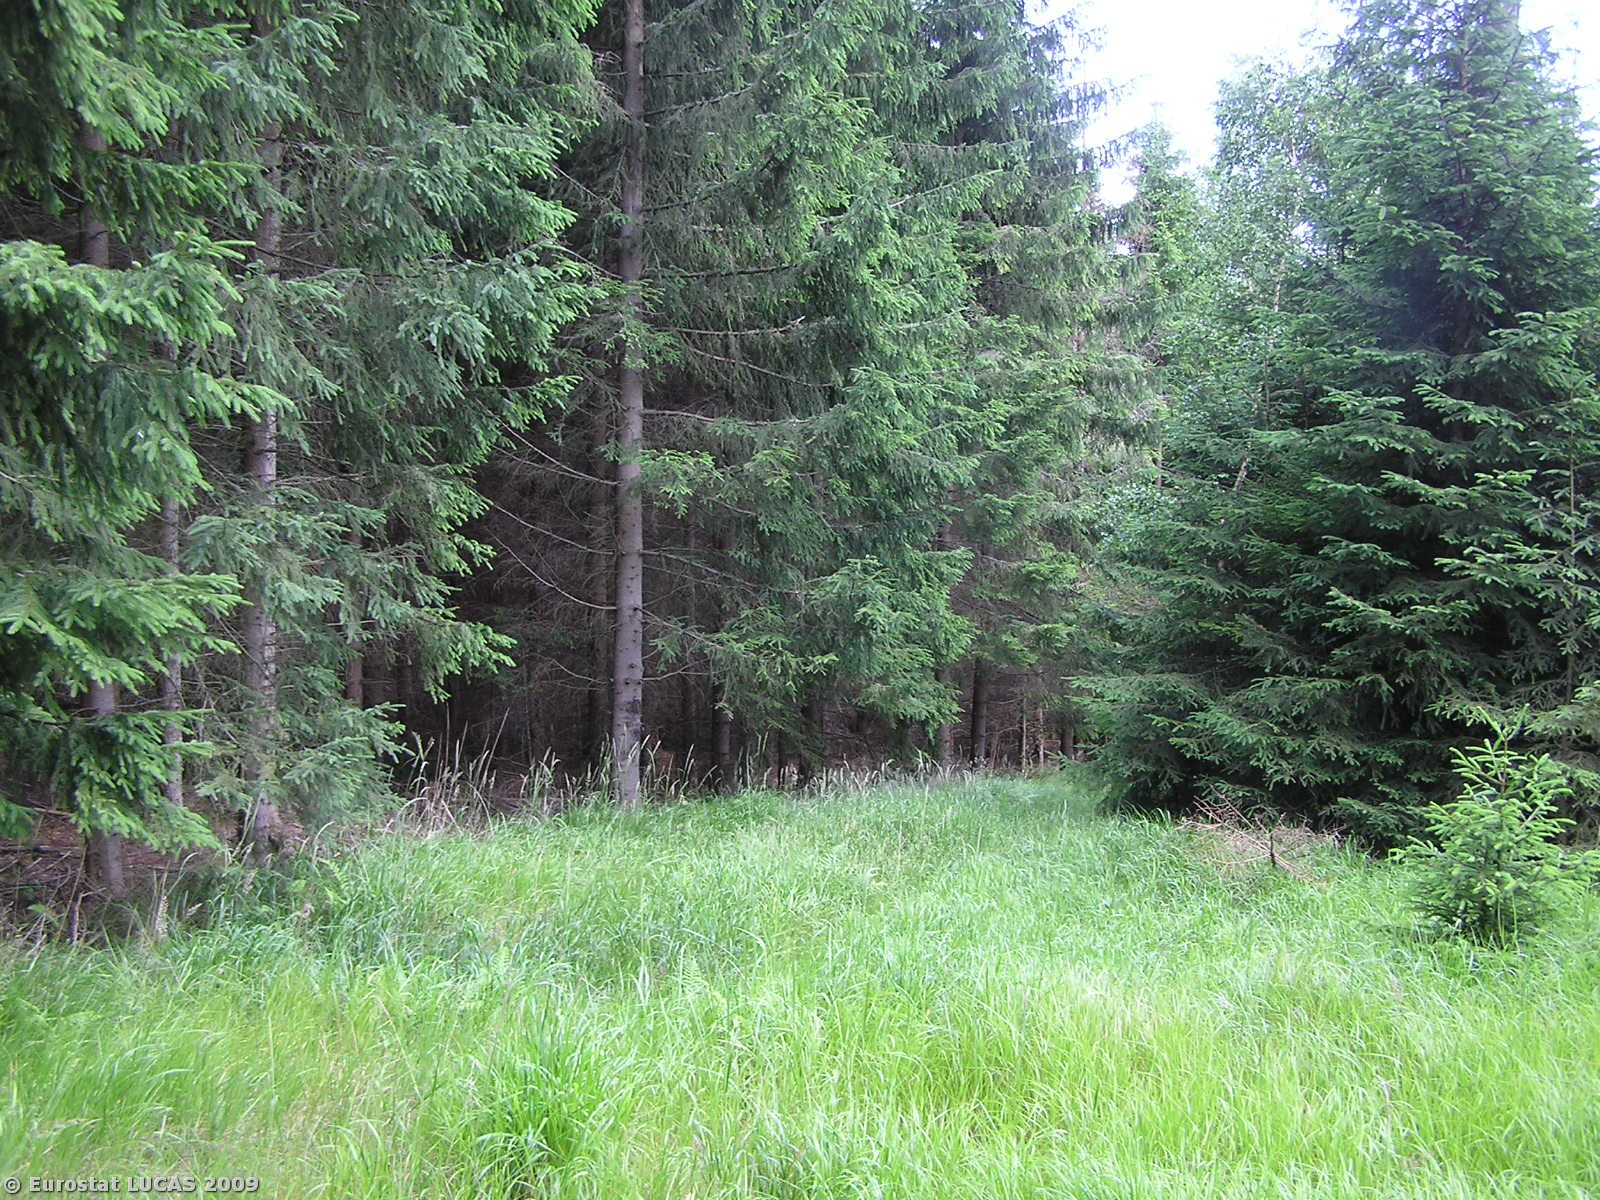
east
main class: Woodland
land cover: Coniferous woodland
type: hemiboreal forest and nemoral coniferous forest and mixed broadleaved-coniferous forest
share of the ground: > 75 %
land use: Forestry
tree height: > 5 m
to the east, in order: Coniferous woodland; Tracks; Coniferous woodland; Ditches and canals; Mixed woodland
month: July
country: CZ
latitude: 50.1001
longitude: 17.4919
